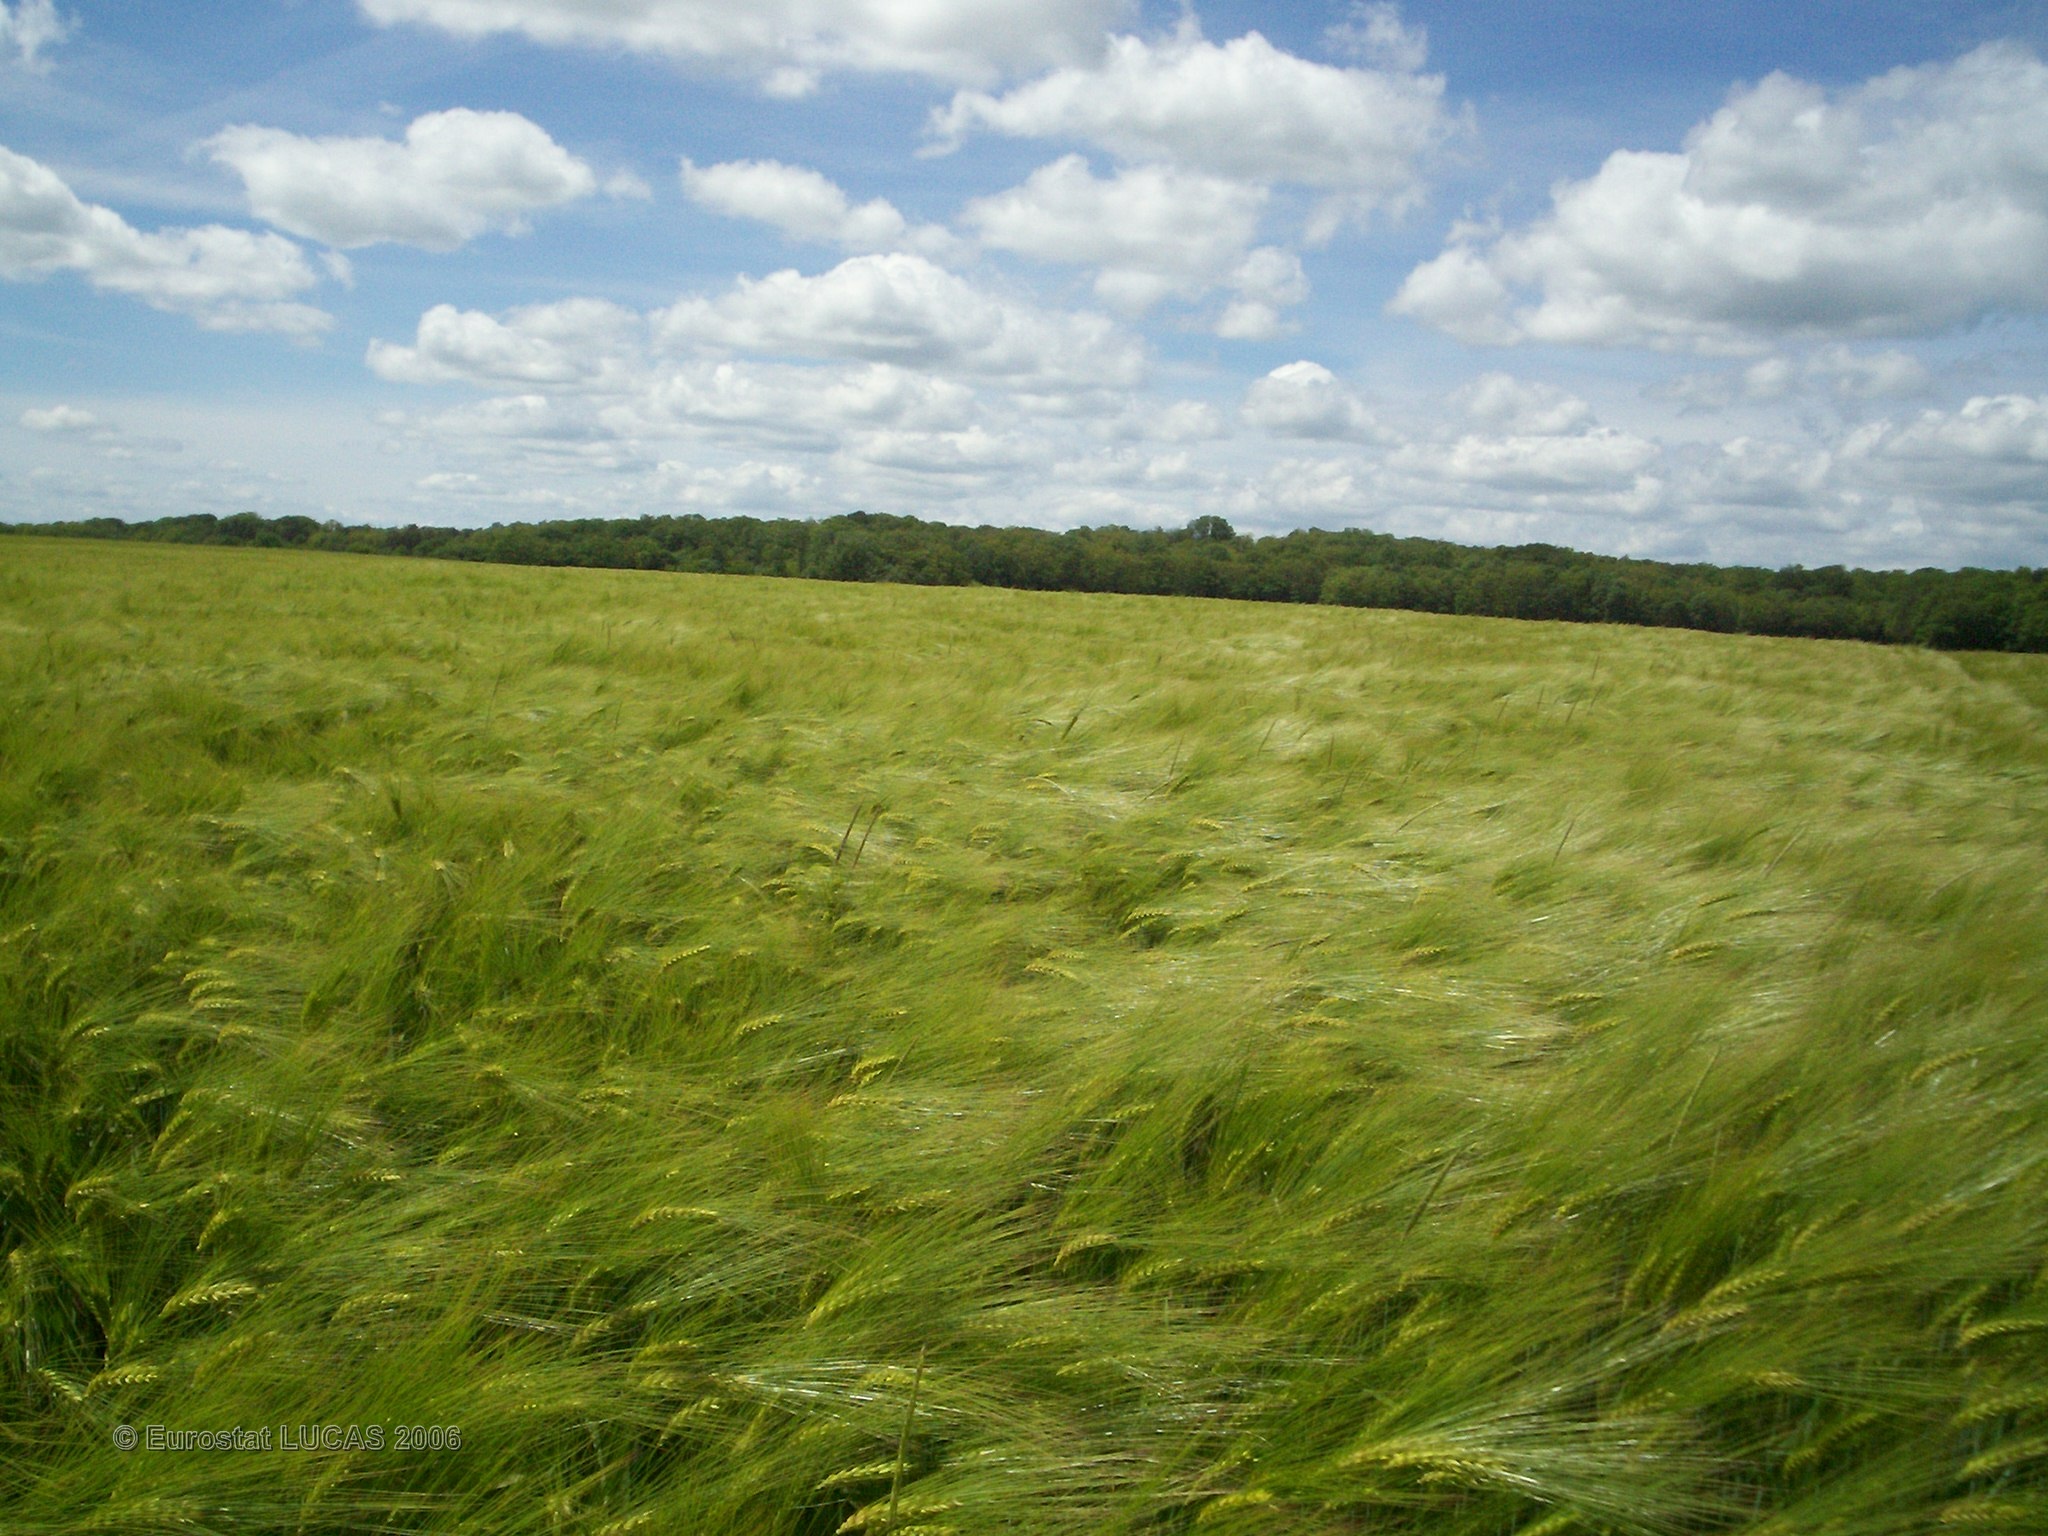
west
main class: Cropland
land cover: Barley
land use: Agriculture (excluding fallow land and kitchen gardens)
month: May
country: FR
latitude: 47.5953
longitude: 4.0797
